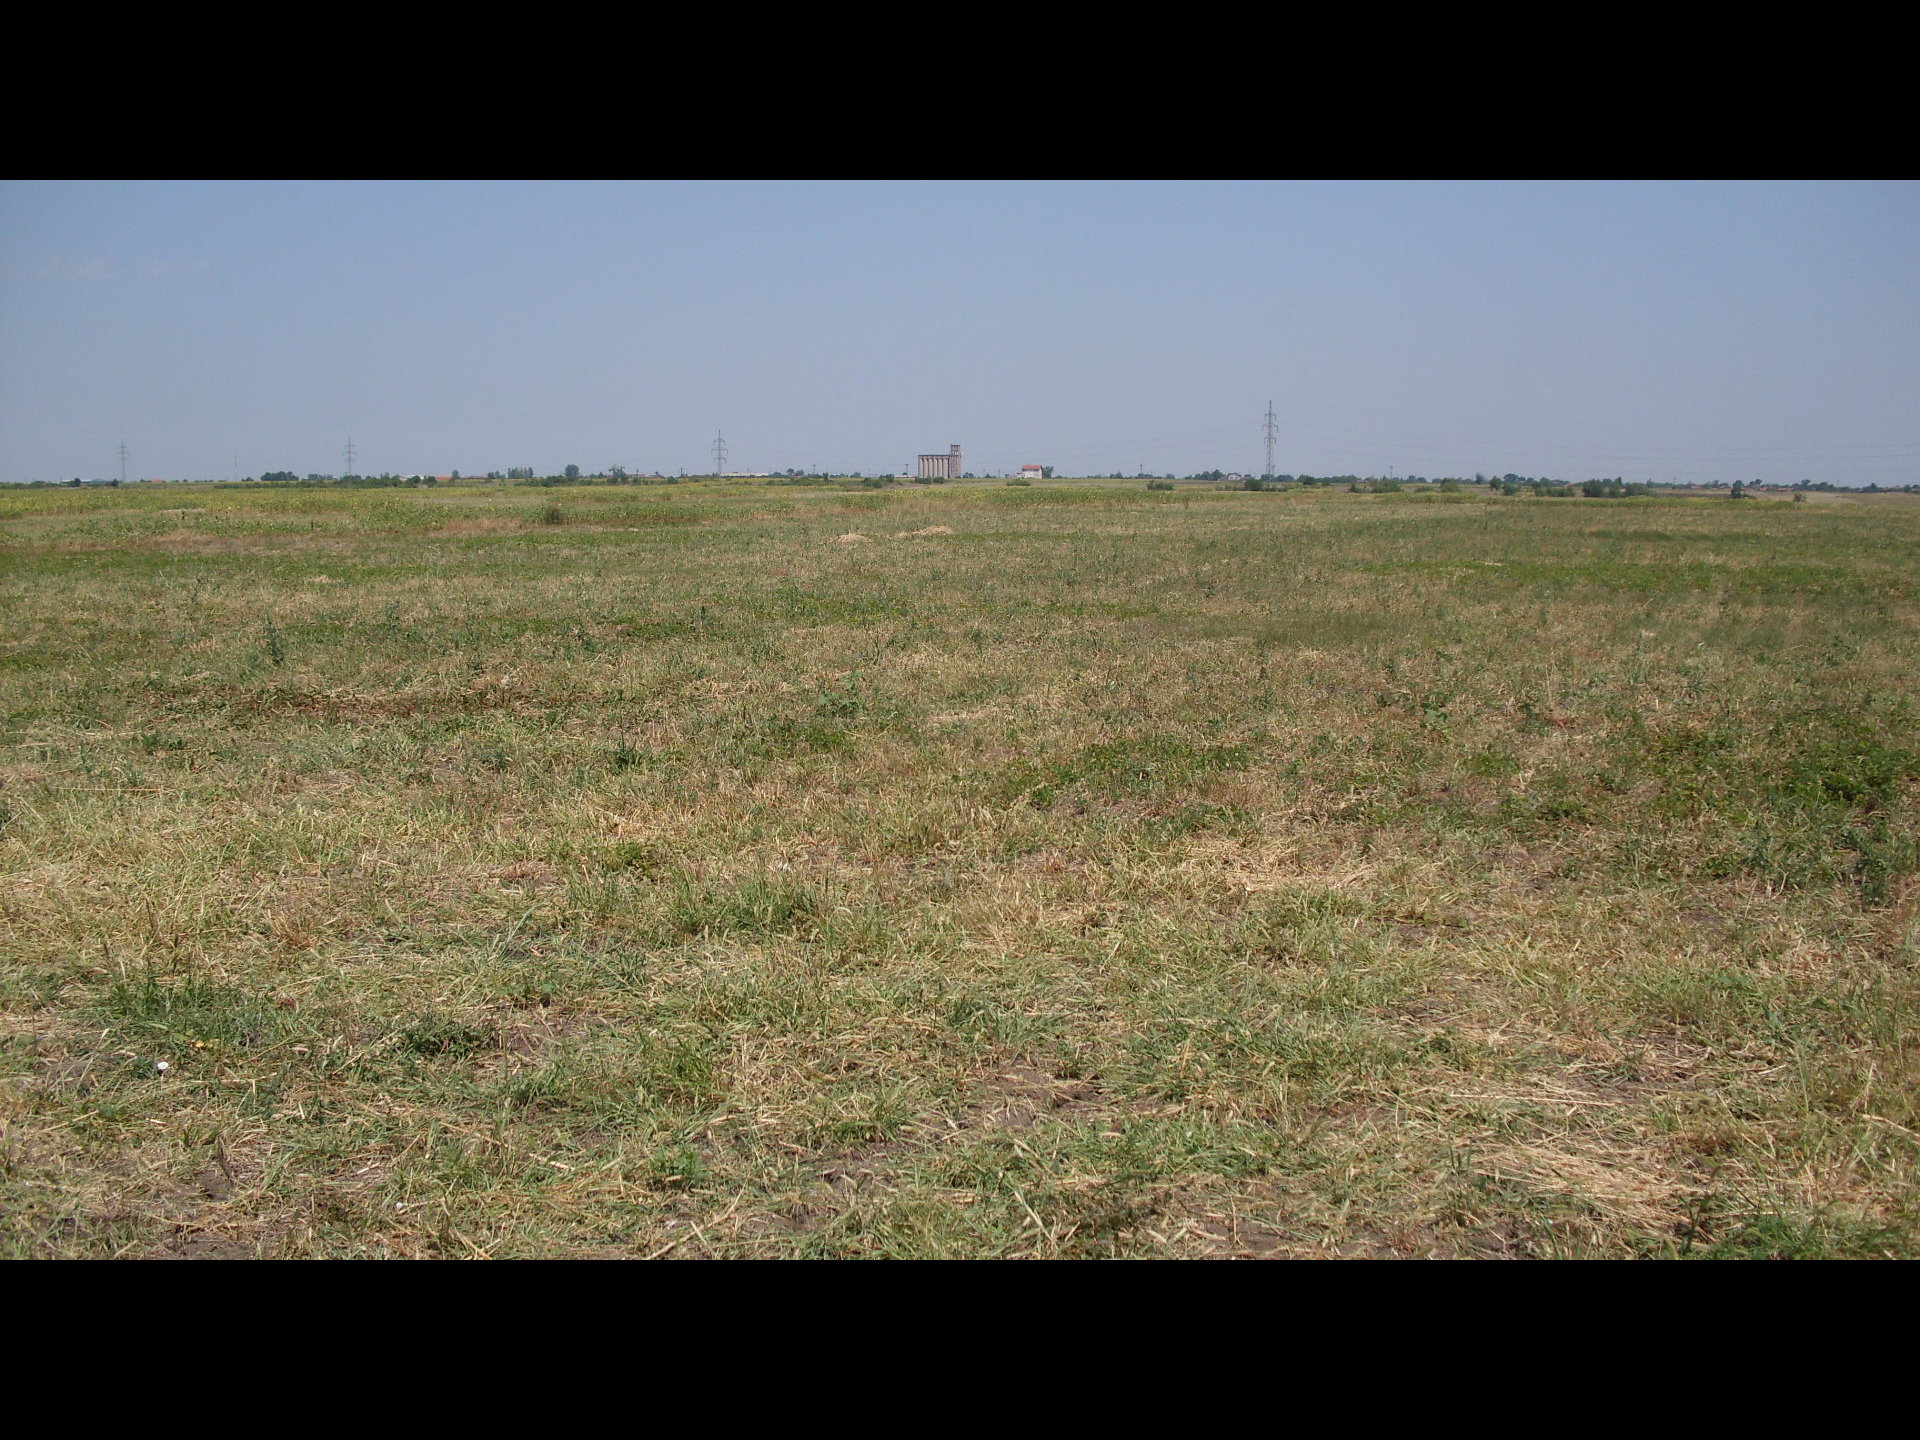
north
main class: Grassland
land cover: Spontaneously vegetated surfaces
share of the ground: > 75 %
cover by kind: herbaceous plants 100 %
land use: Agriculture (excluding fallow land and kitchen gardens)
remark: Harvested field
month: July
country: BG
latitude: 43.5997
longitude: 23.1591
